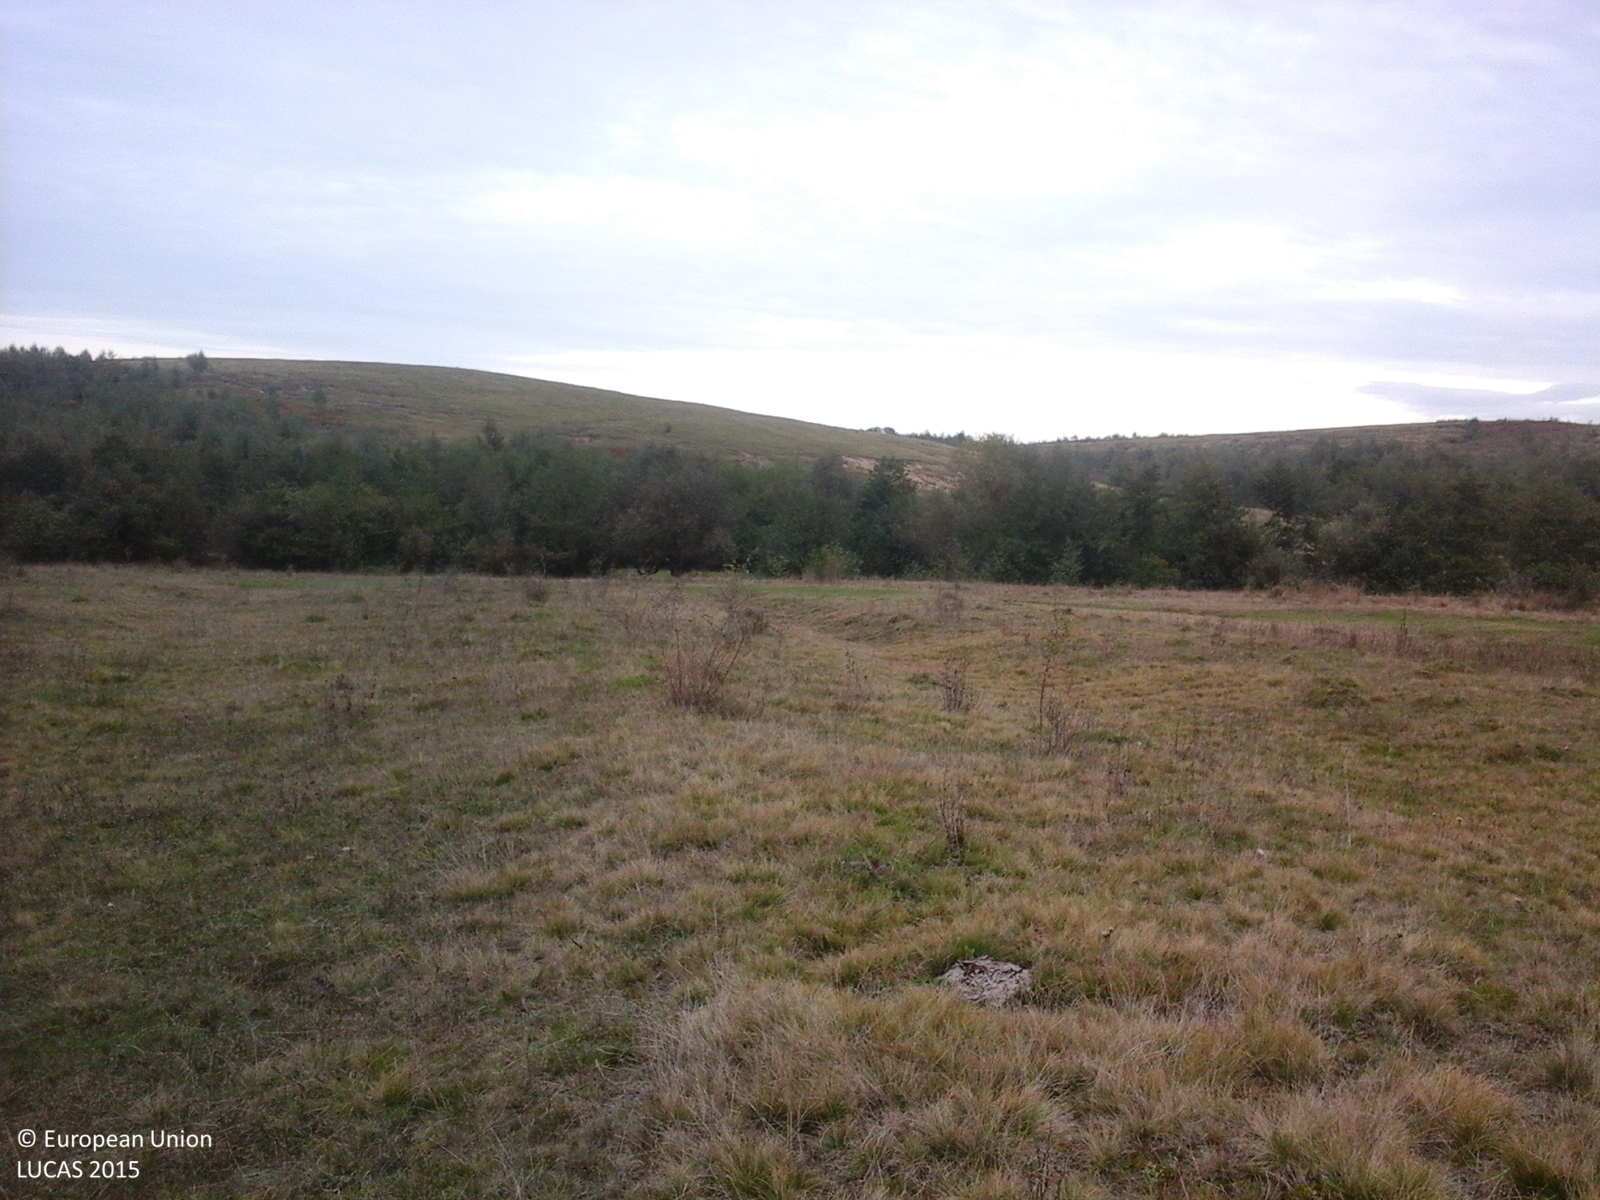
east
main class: Grassland
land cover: Grassland without tree/shrub cover
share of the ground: > 75 %
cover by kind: herbaceous plants 100 %
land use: Agriculture (excluding fallow land and kitchen gardens)
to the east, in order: Grassland without tree/shrub cover; Tracks; Grassland without tree/shrub cover; Rivers and streams; Broadleaved woodland; Grassland without tree/shrub cover; Ditches and canals; Grassland without tree/shrub cover
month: October
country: RO
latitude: 45.7272
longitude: 25.1151
